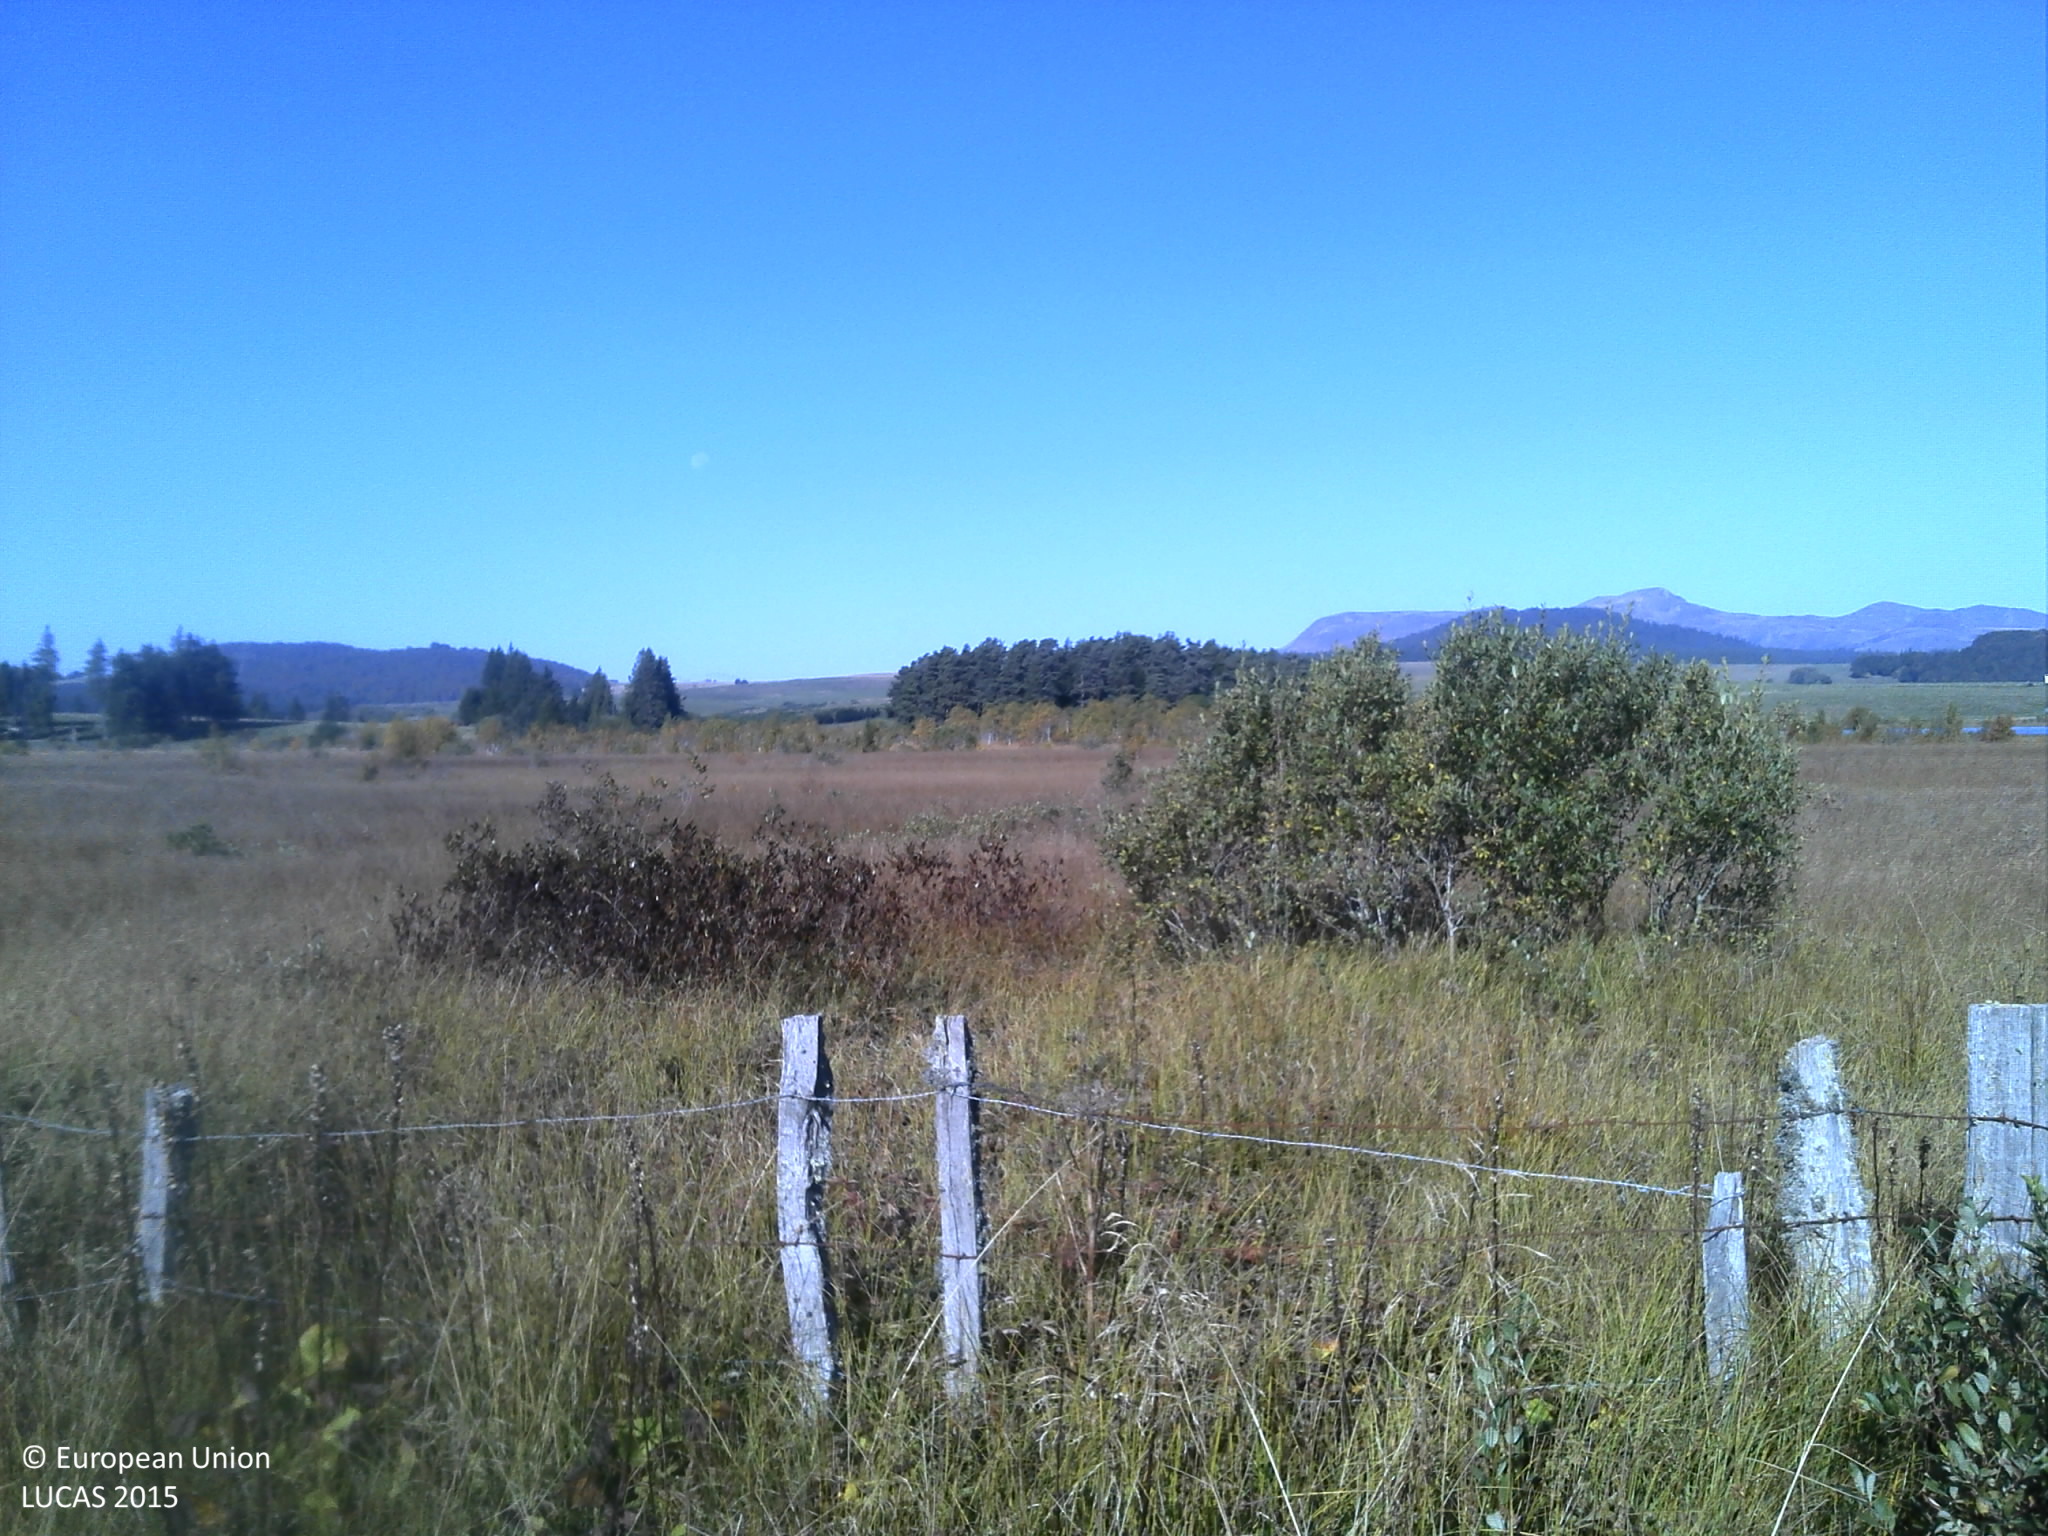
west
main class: Grassland
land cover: Grassland without tree/shrub cover
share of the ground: > 75 %
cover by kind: herbaceous plants 100 %
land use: Semi-natural and natural areas not in use
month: October
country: FR
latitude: 45.4660
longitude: 2.9274
